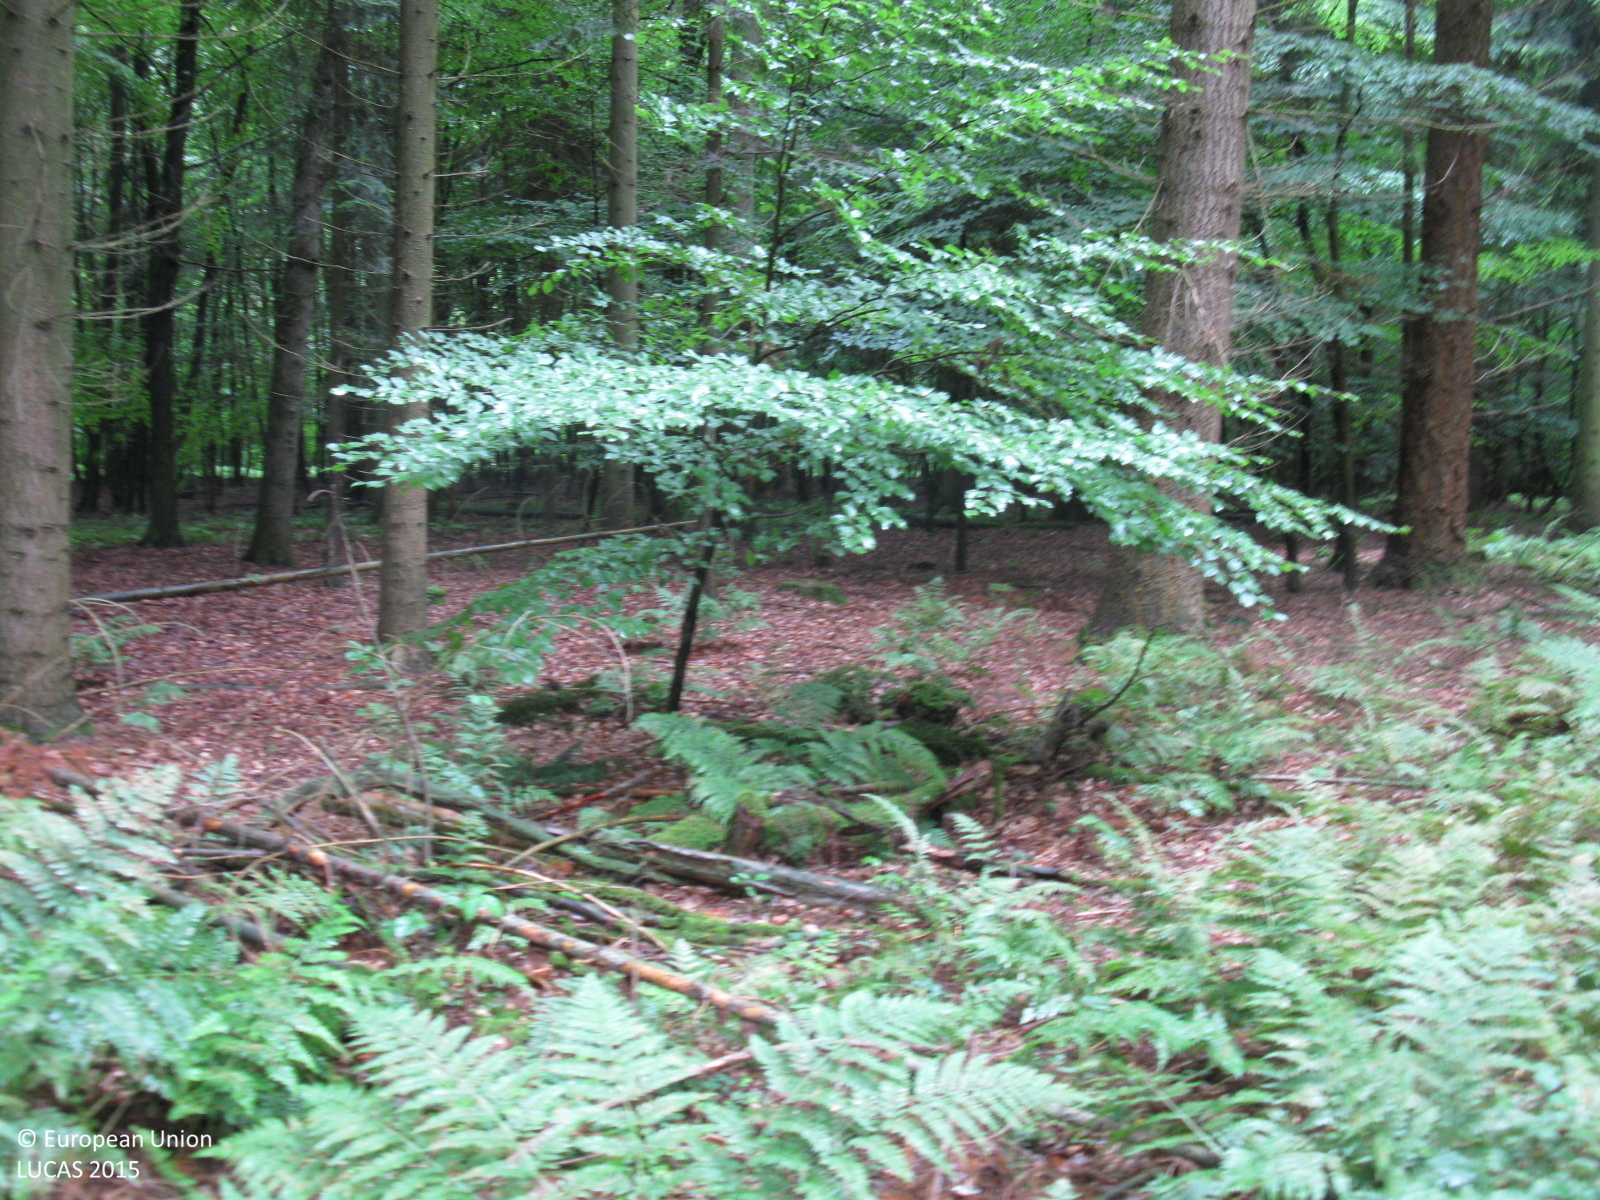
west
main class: Woodland
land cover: Other coniferous woodland
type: hemiboreal forest and nemoral coniferous forest and mixed broadleaved-coniferous forest
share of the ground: > 75 %
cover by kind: coniferous forest trees 100 %
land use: Forestry
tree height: > 5 m
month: July
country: DE
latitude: 52.9263
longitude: 8.5874
